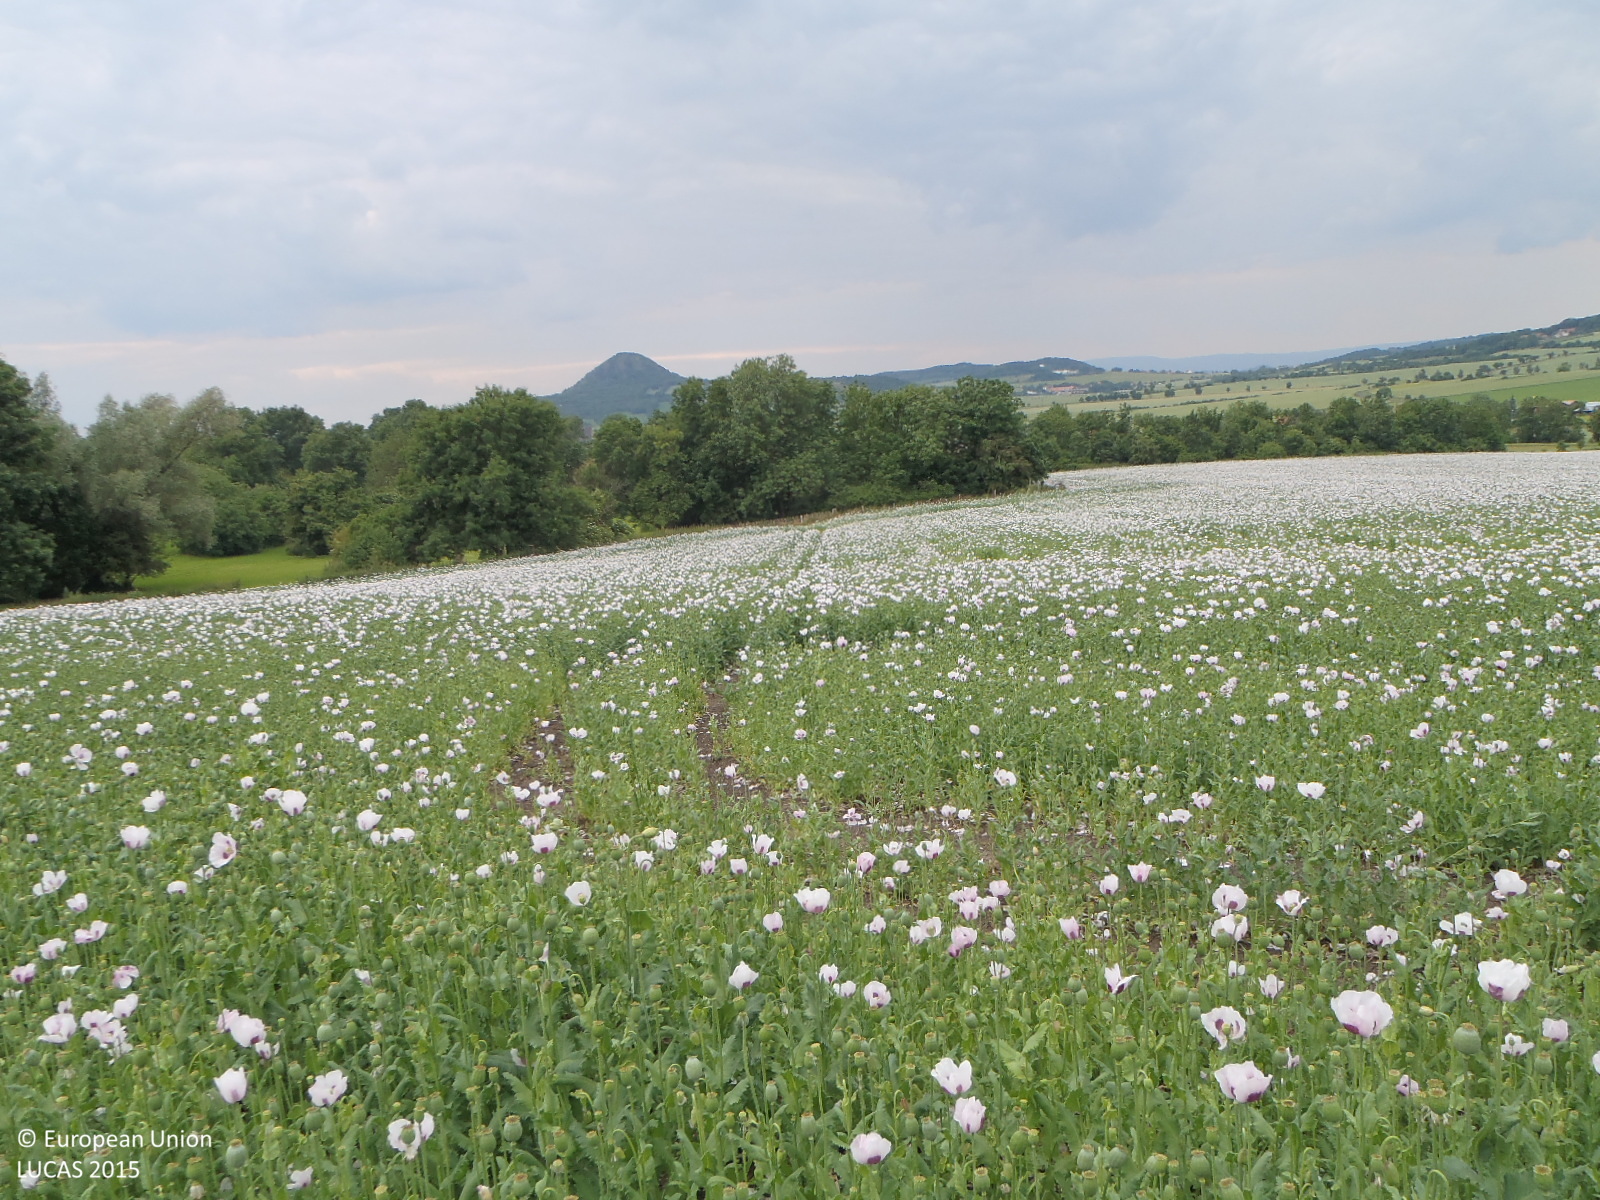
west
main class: Cropland
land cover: Other fibre and oleaginous crops
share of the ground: > 75 %
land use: Agriculture (excluding fallow land and kitchen gardens)
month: June
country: CZ
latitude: 50.4265
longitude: 13.8154
